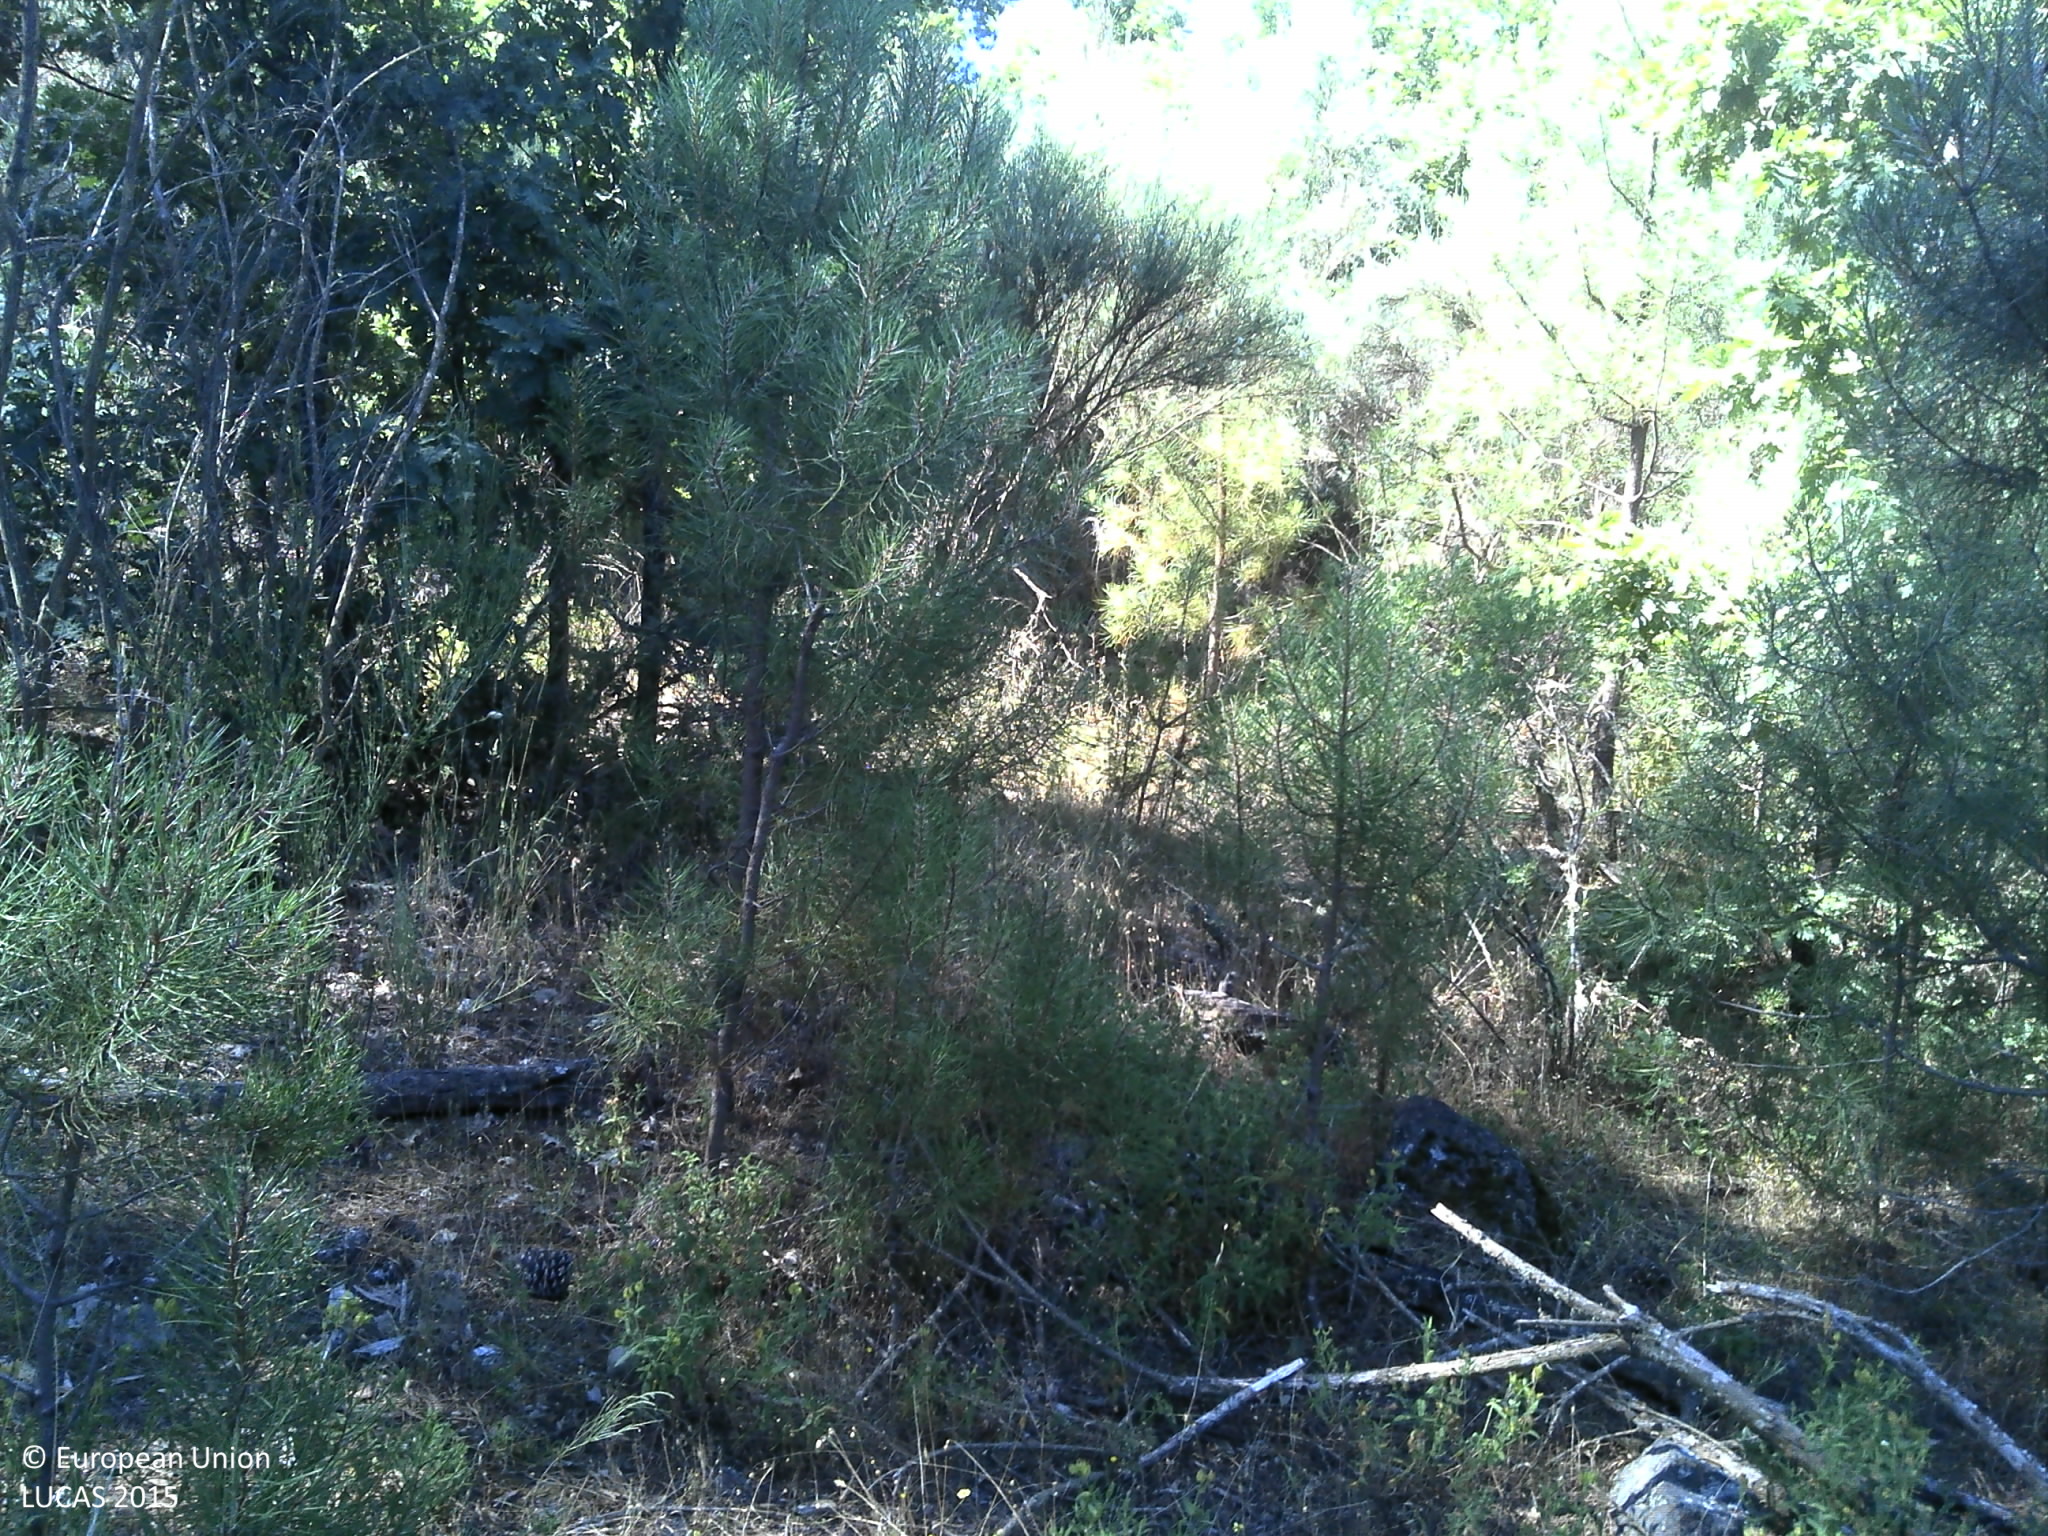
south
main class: Woodland
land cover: Pine dominated mixed woodland
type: coniferous forest of the mediterranean region
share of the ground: 50 - 75 %
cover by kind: shrubs 50 %, coniferous forest trees 30 %, broadleaved forest trees 10 %, unconsolidated bare surface 10 %
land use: Forestry
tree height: > 5 m
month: June
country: PT
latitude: 40.7597
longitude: -7.2253
